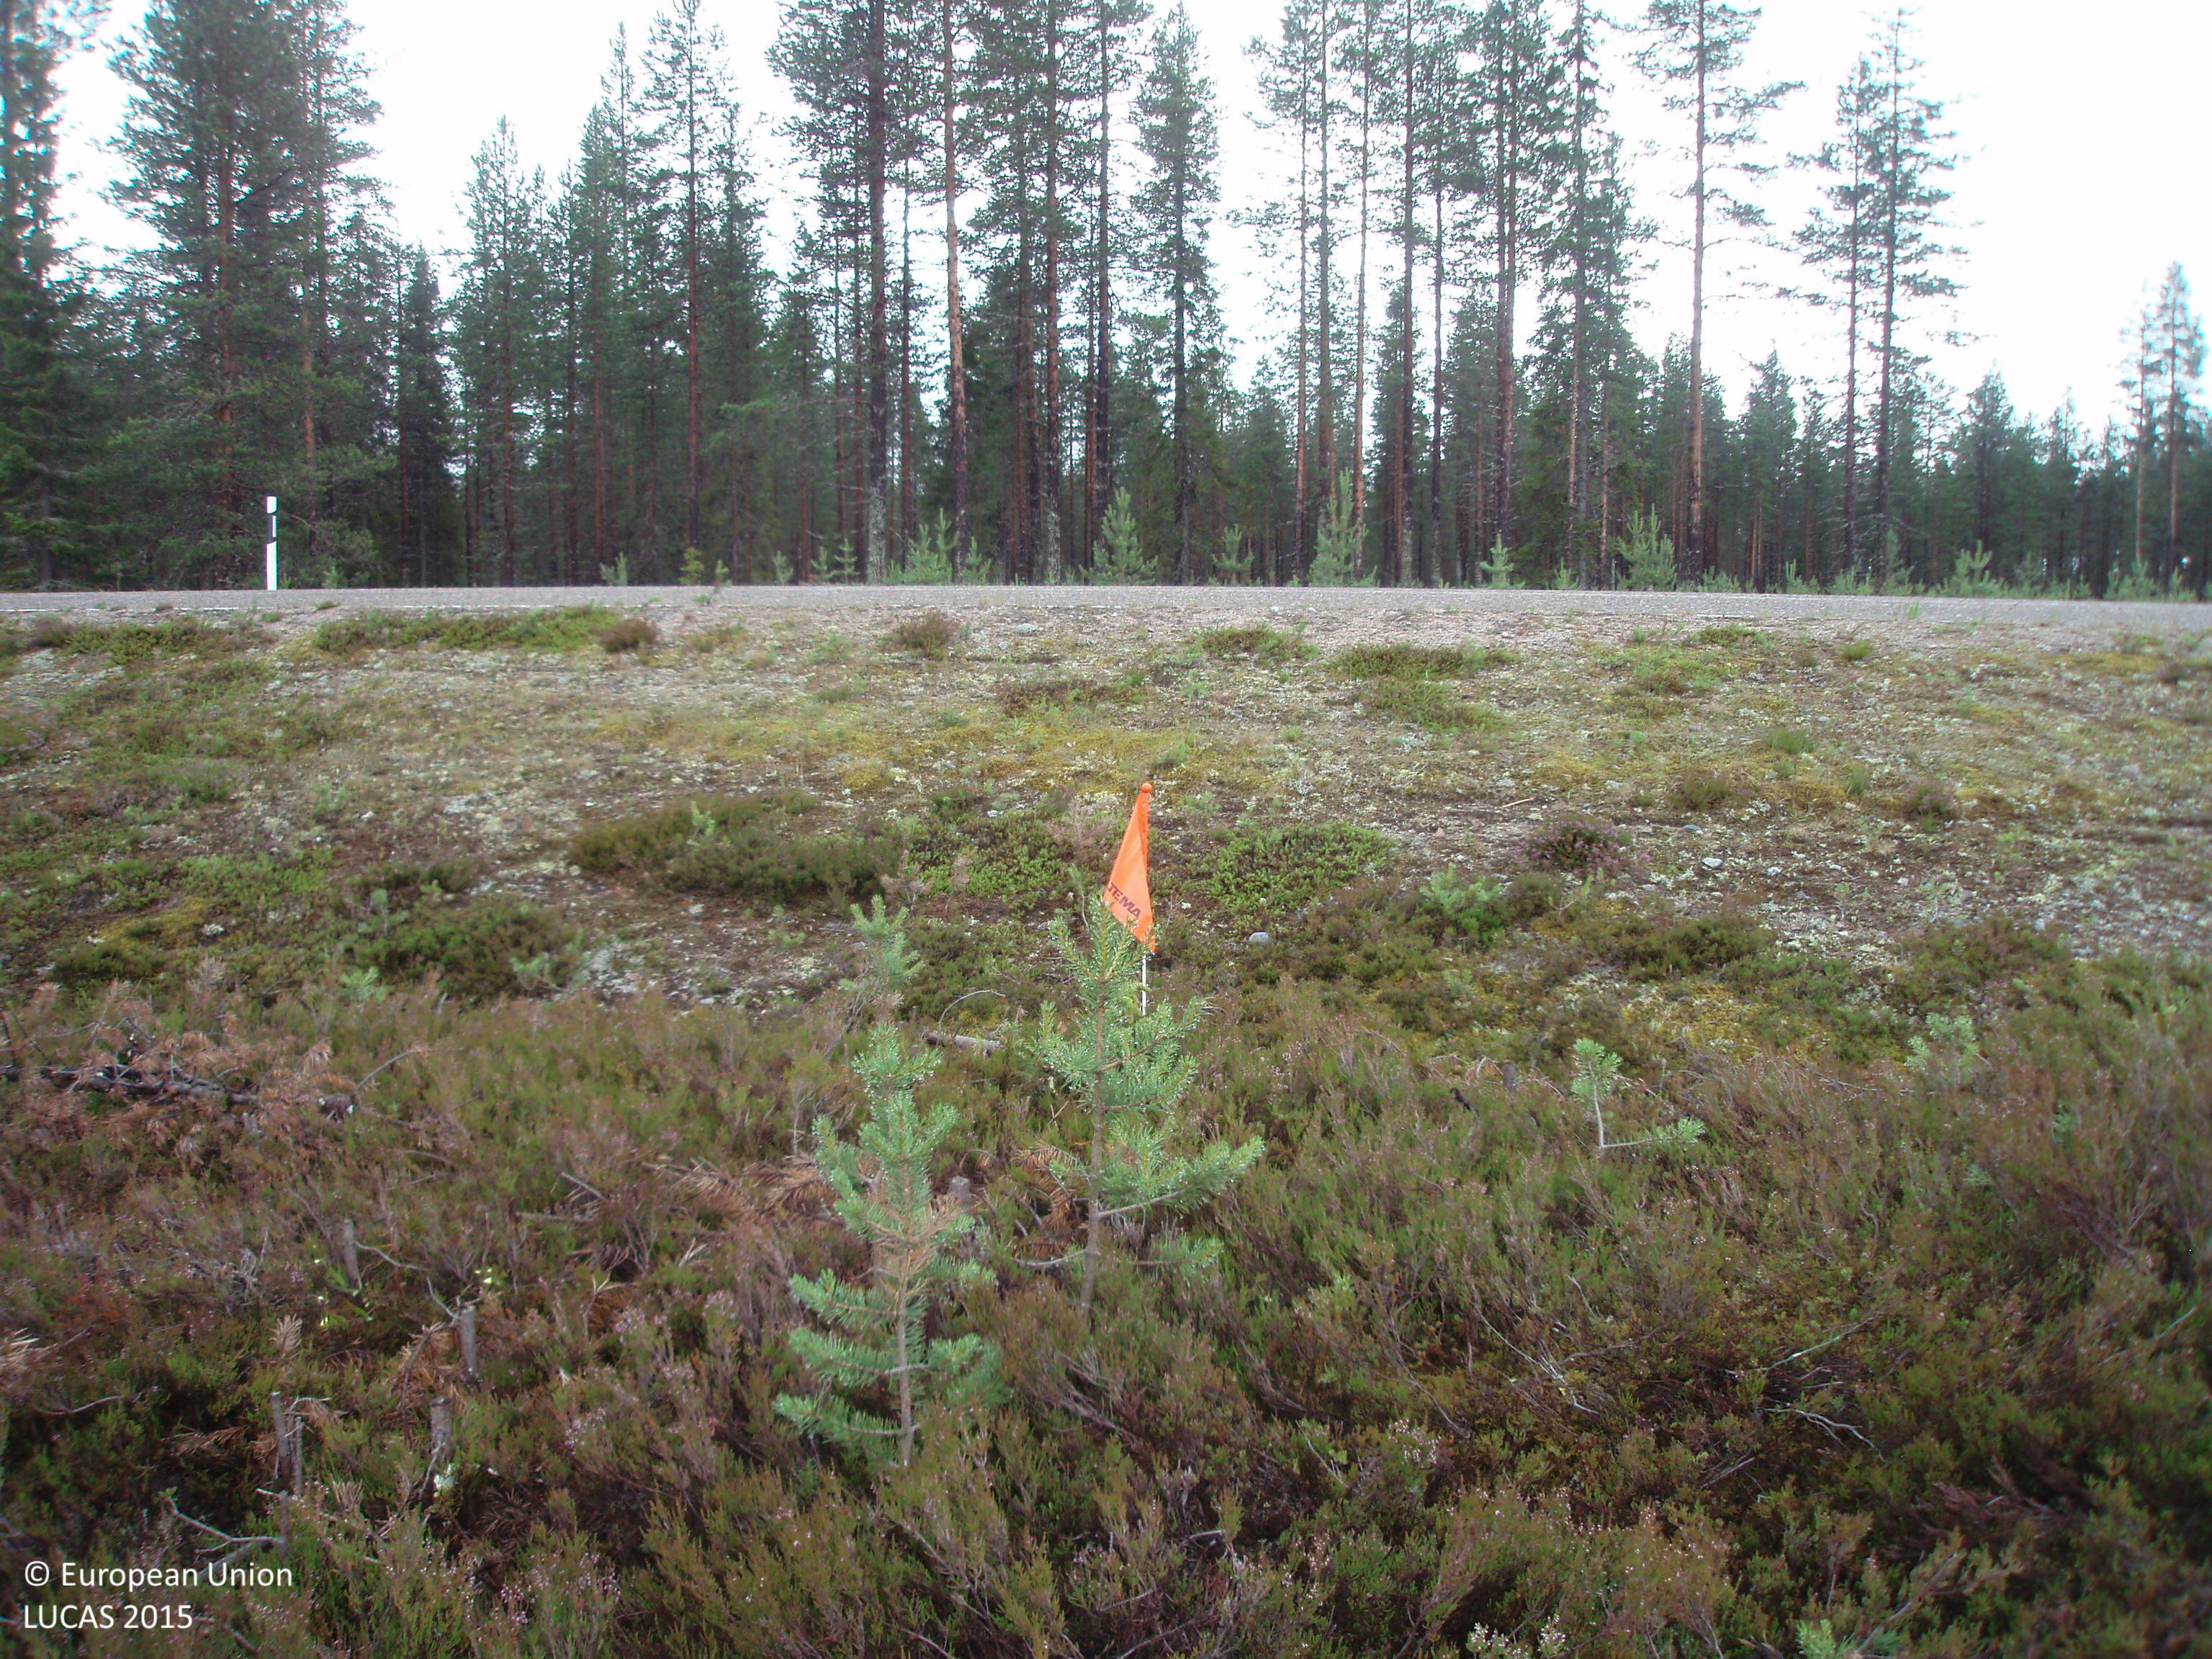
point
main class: Shrubland
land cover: Shrubland with sparse tree cover
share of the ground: 50 - 75 %
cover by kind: shrubs 65 %, lichens and mosses 20 %, unconsolidated bare surface 10 %, coniferous forest trees 5 %
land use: Road transport
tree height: < 5 m
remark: Clear cut
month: July
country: FI
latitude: 66.0606
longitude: 28.0038
